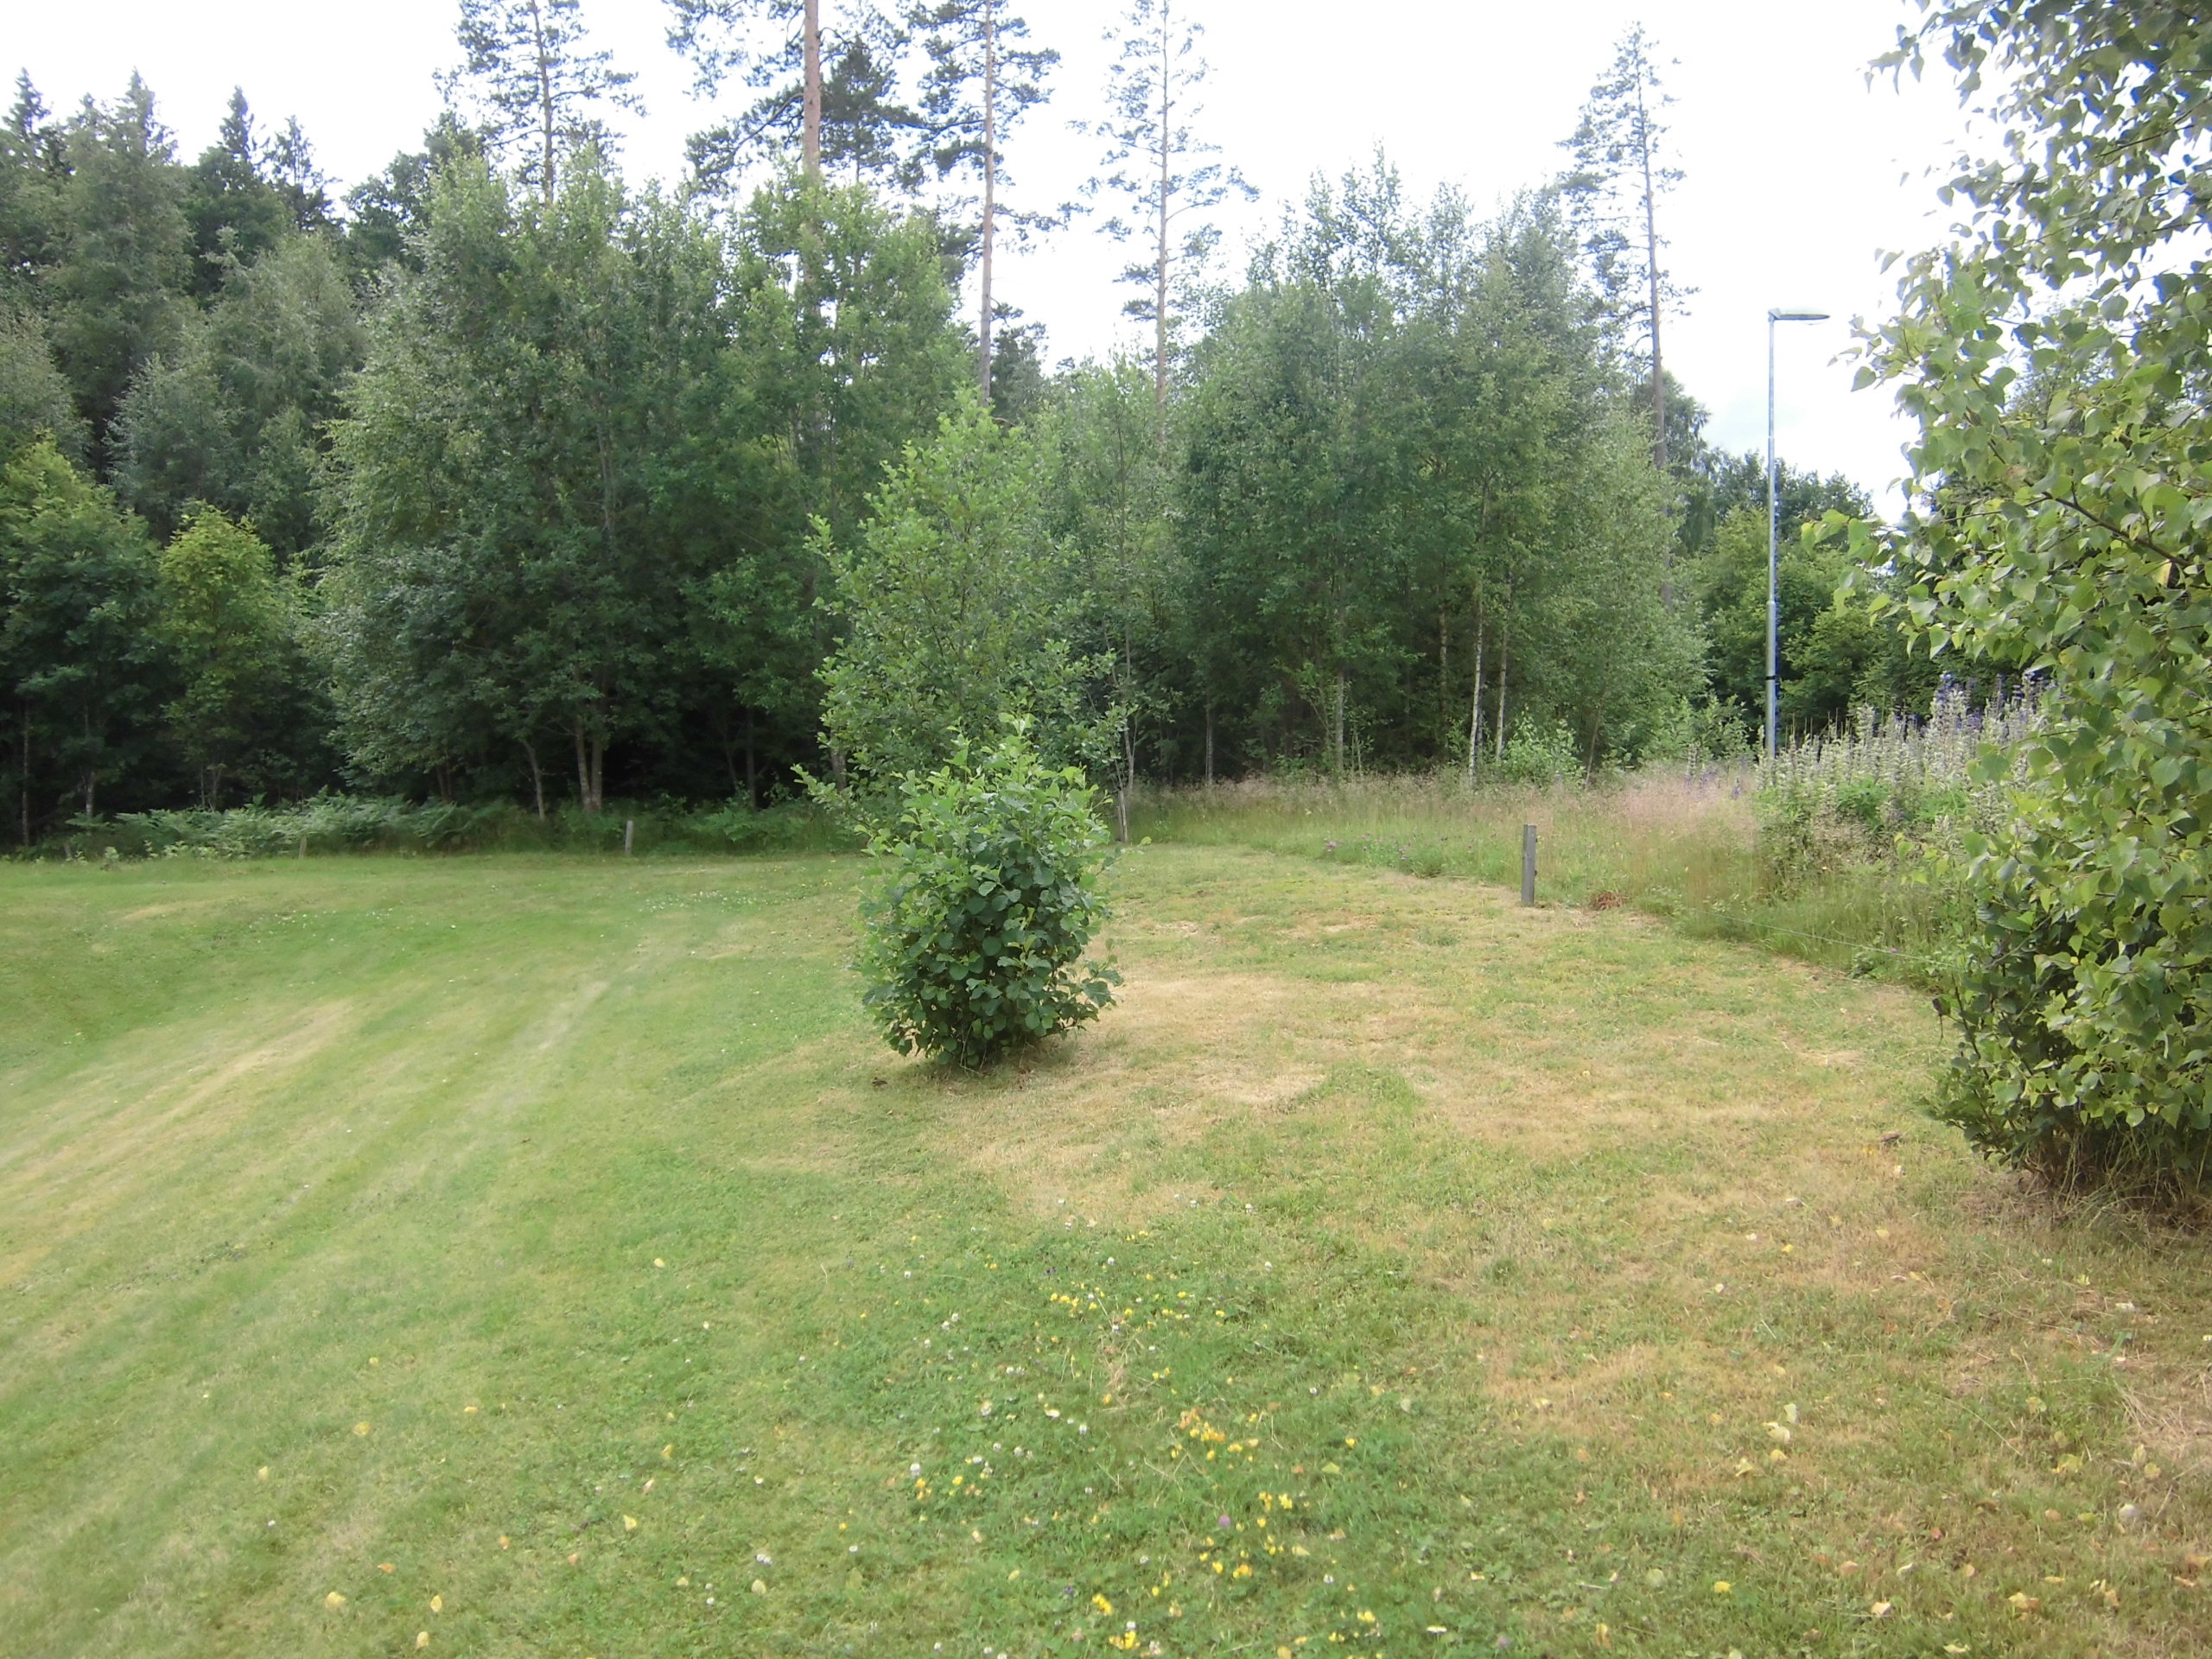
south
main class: Grassland
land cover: Grassland with sparse tree/shrub cover
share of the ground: > 75 %
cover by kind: herbaceous plants 95 %, coniferous forest trees 5 %
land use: Sport
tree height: < 5 m
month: July
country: SE
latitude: 57.3107
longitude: 15.1265
